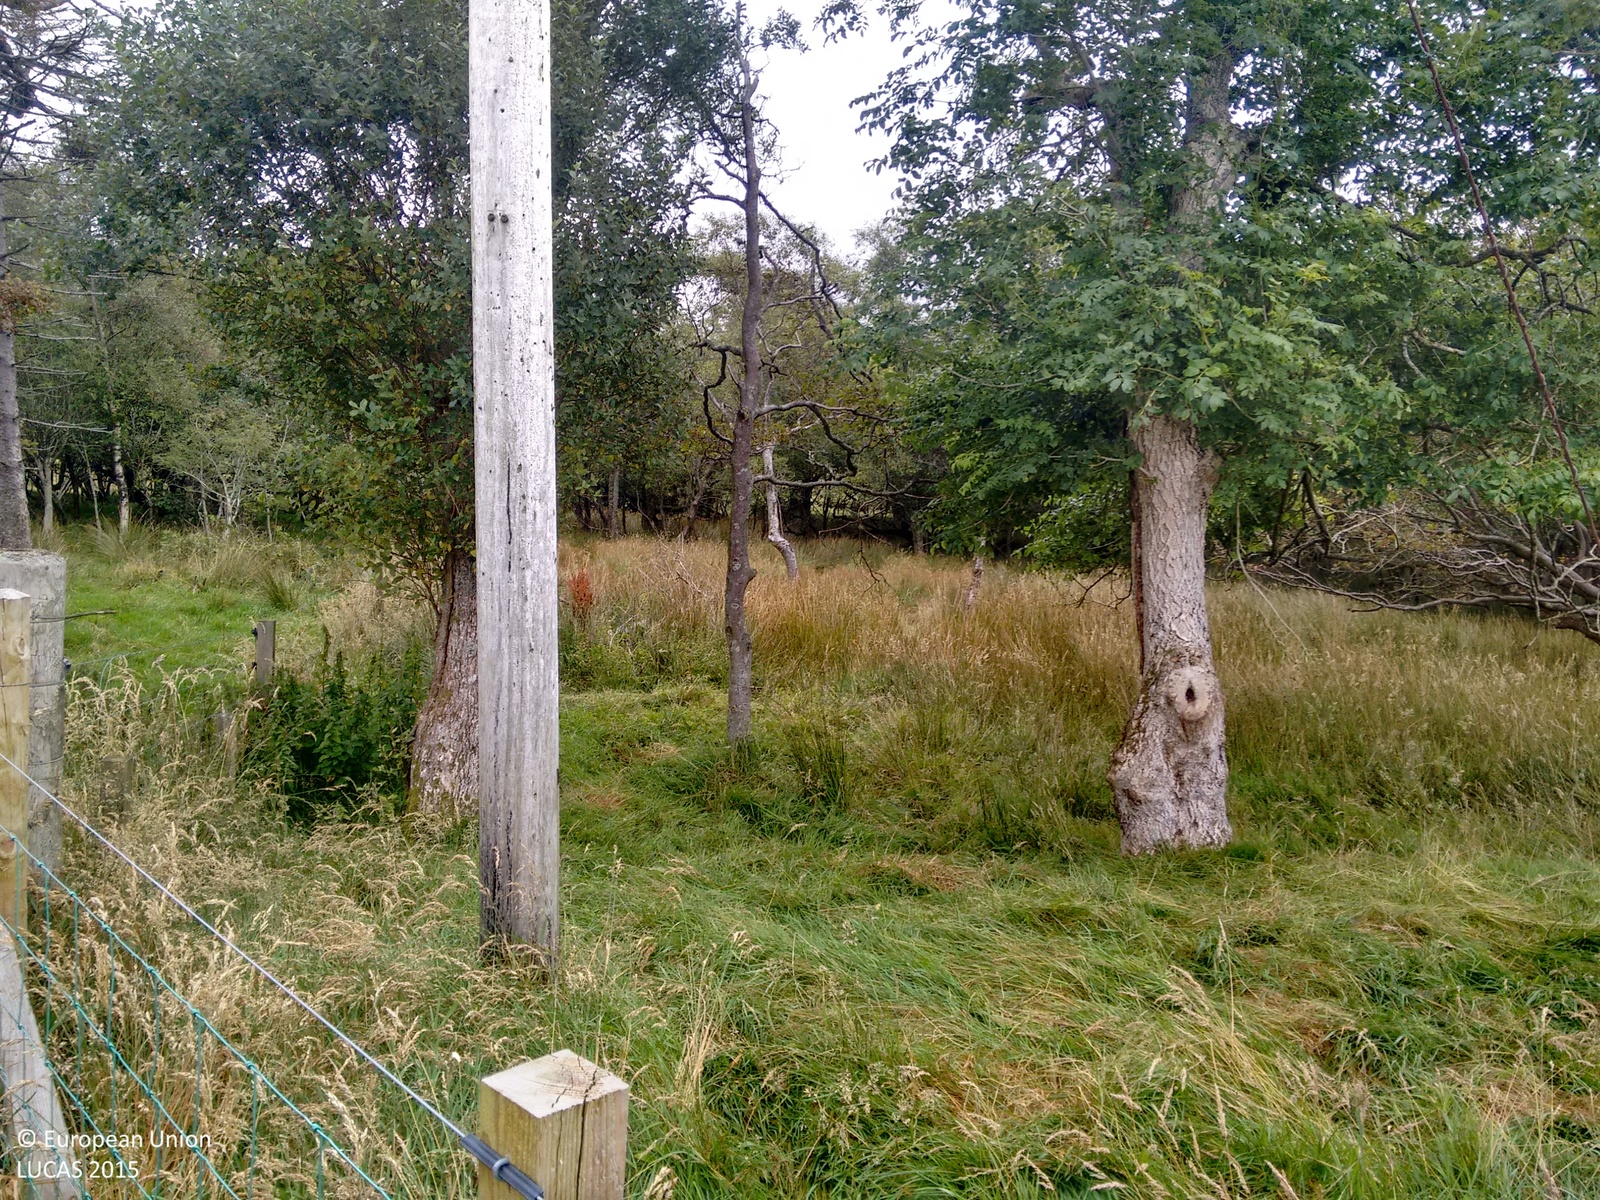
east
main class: Grassland
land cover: Grassland without tree/shrub cover
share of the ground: > 75 %
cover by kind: herbaceous plants 100 %
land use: Agriculture (excluding fallow land and kitchen gardens)
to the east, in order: Grassland without tree/shrub cover; Ditches and canals; Broadleaved woodland; Fences; Grassland without tree/shrub cover
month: September
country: GB
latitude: 55.1876
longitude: -4.8578
